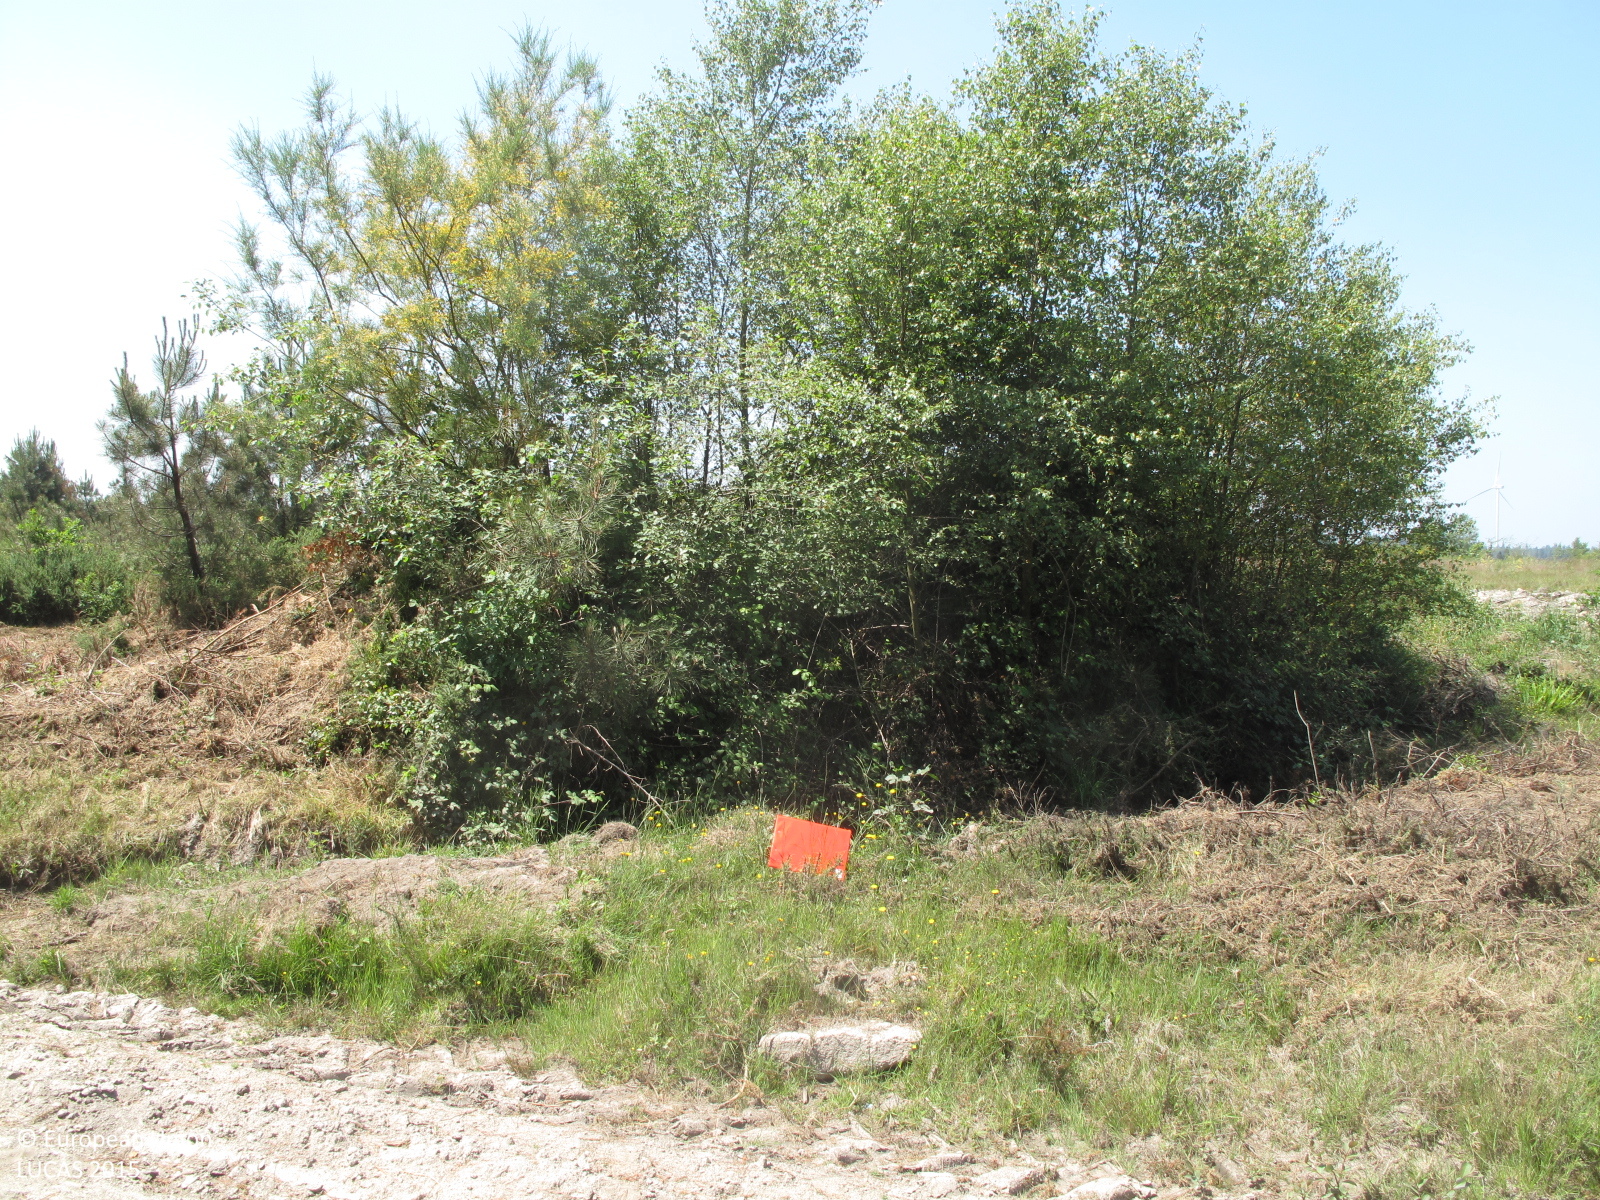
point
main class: Woodland
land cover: Pine dominated mixed woodland
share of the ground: 10 - 25 %
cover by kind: shrubs 60 %, herbaceous plants 30 %, coniferous forest trees 5 %, broadleaved forest trees 5 %
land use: Forestry
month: June
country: ES
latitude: 43.2336
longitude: -7.9330
